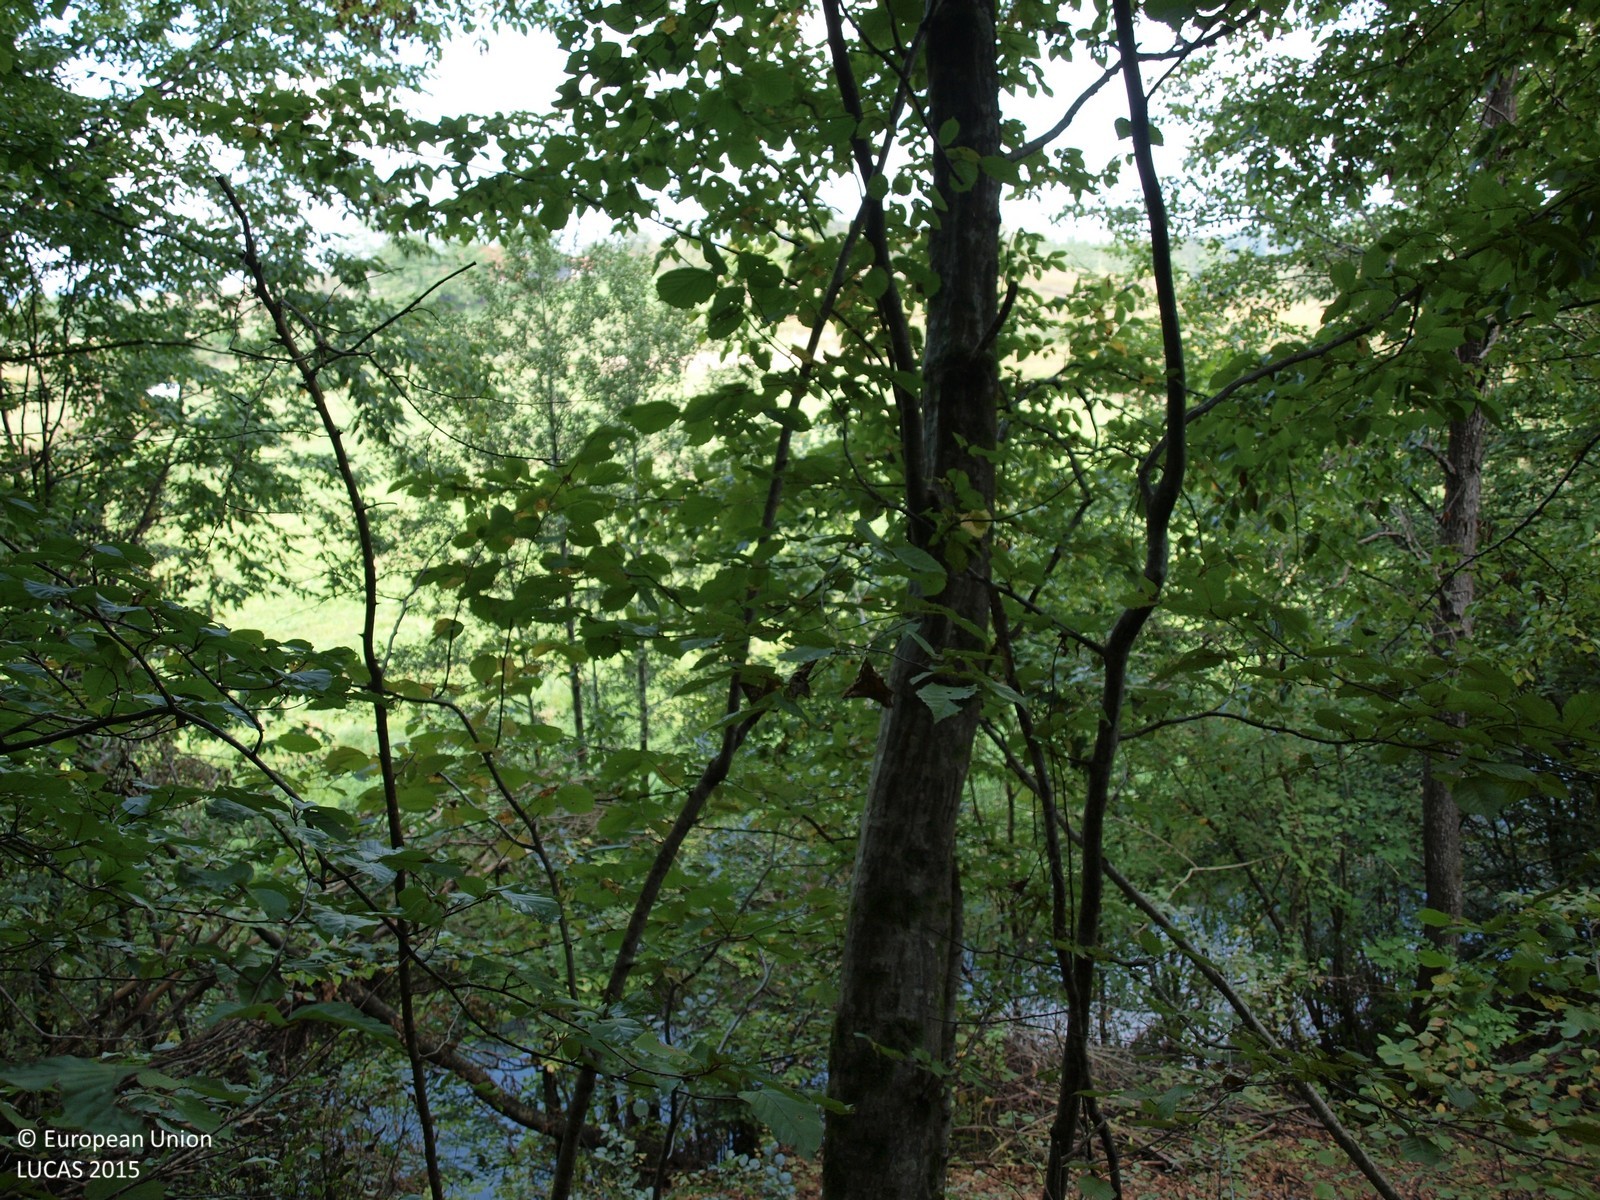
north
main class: Woodland
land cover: Broadleaved woodland
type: mesophytic deciduous forest
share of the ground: > 75 %
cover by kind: broadleaved forest trees 100 %
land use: Forestry
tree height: > 5 m
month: October
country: HR
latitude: 45.2673
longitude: 15.8972
